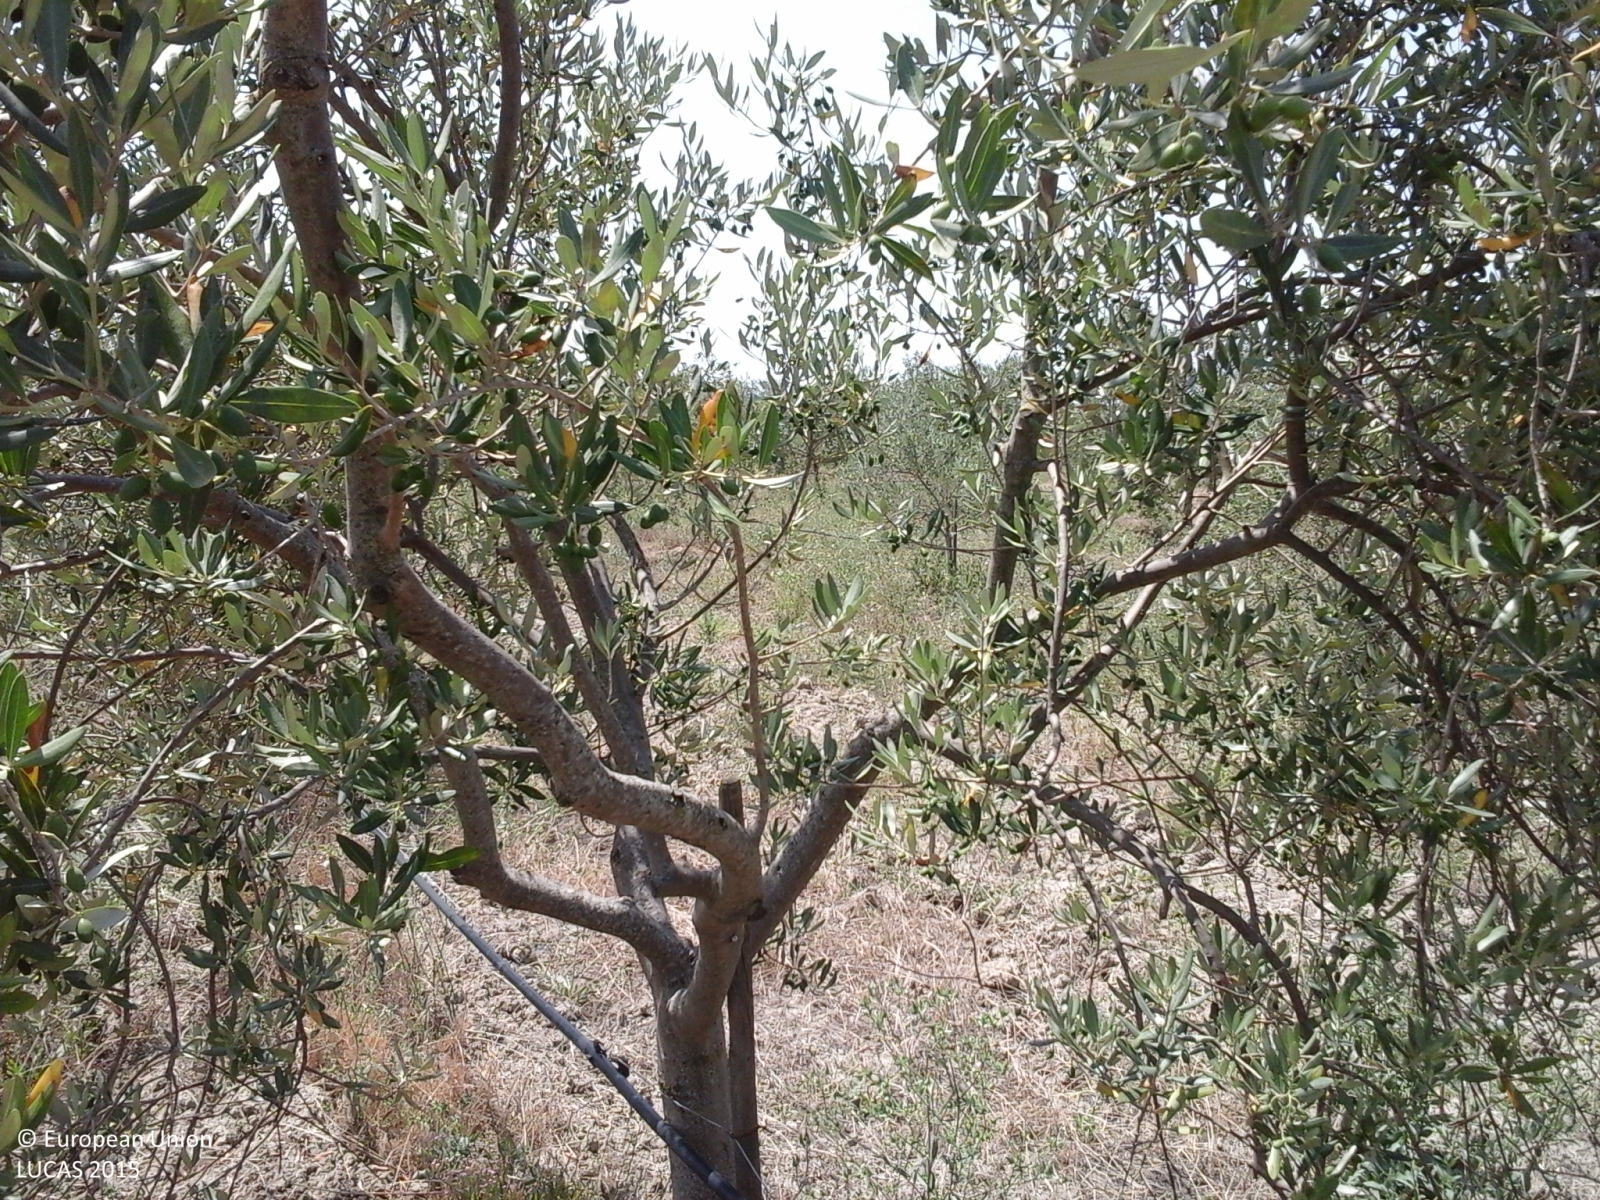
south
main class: Cropland
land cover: Olive groves
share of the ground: 50 - 75 %
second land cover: Grassland without tree/shrub cover
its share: 50 - 75 %
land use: Agriculture (excluding fallow land and kitchen gardens)
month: July
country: IT
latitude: 42.7576
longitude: 10.9865
